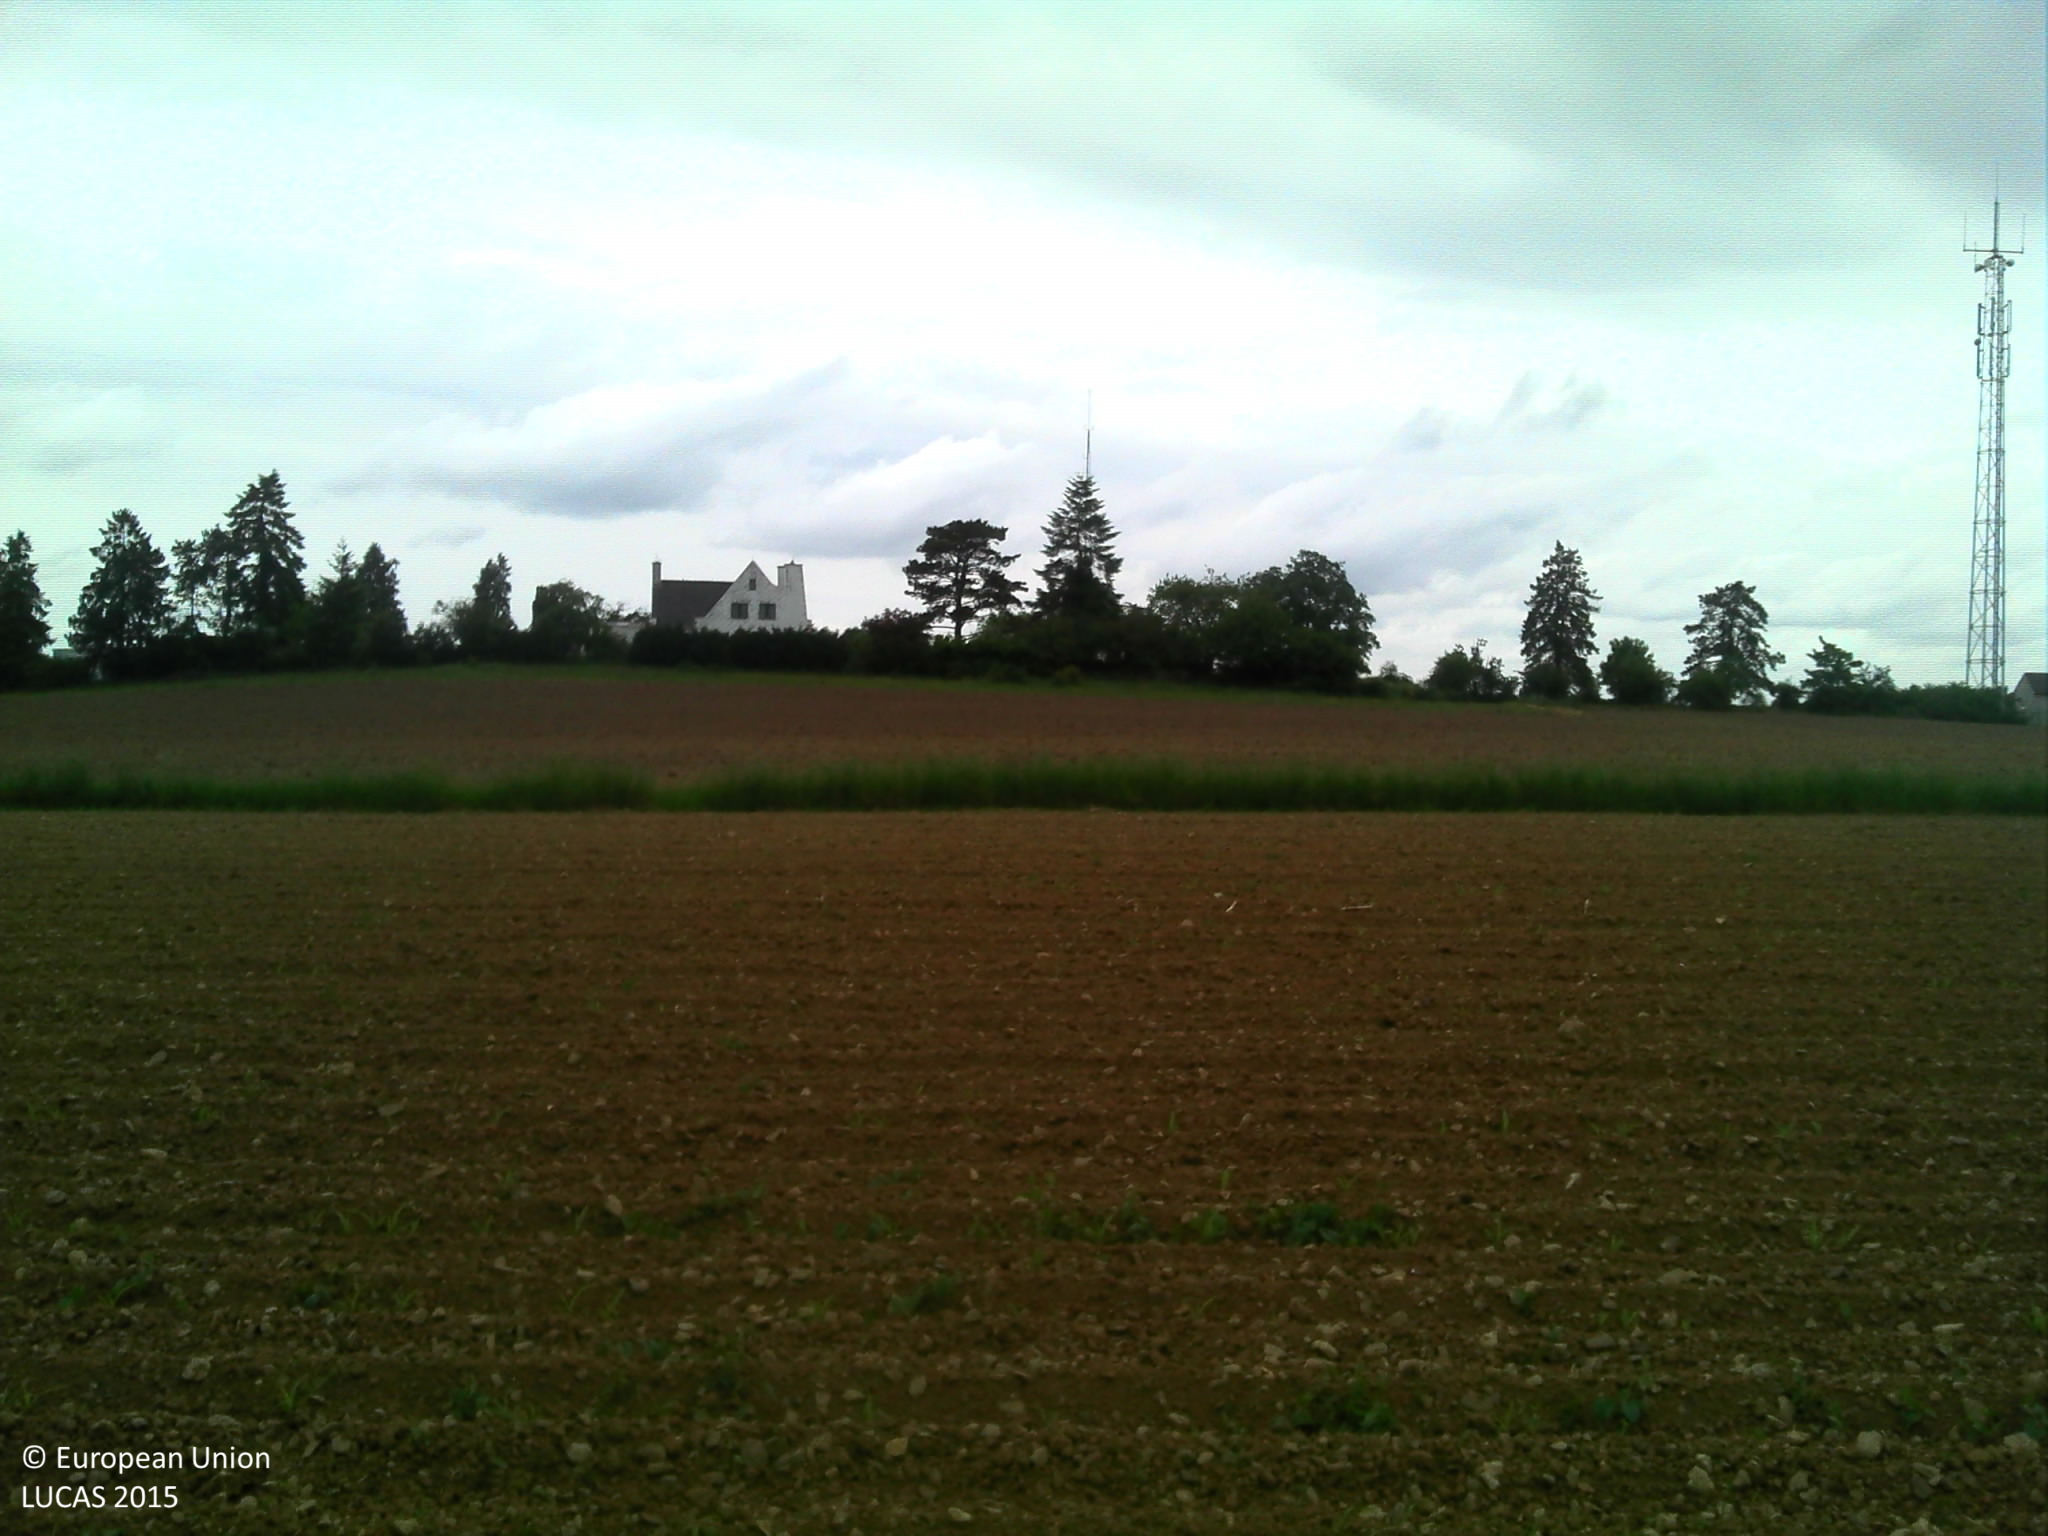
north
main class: Cropland
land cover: Maize
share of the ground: < 10 %
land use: Agriculture (excluding fallow land and kitchen gardens)
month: May
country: BE
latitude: 50.1384
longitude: 5.2267
